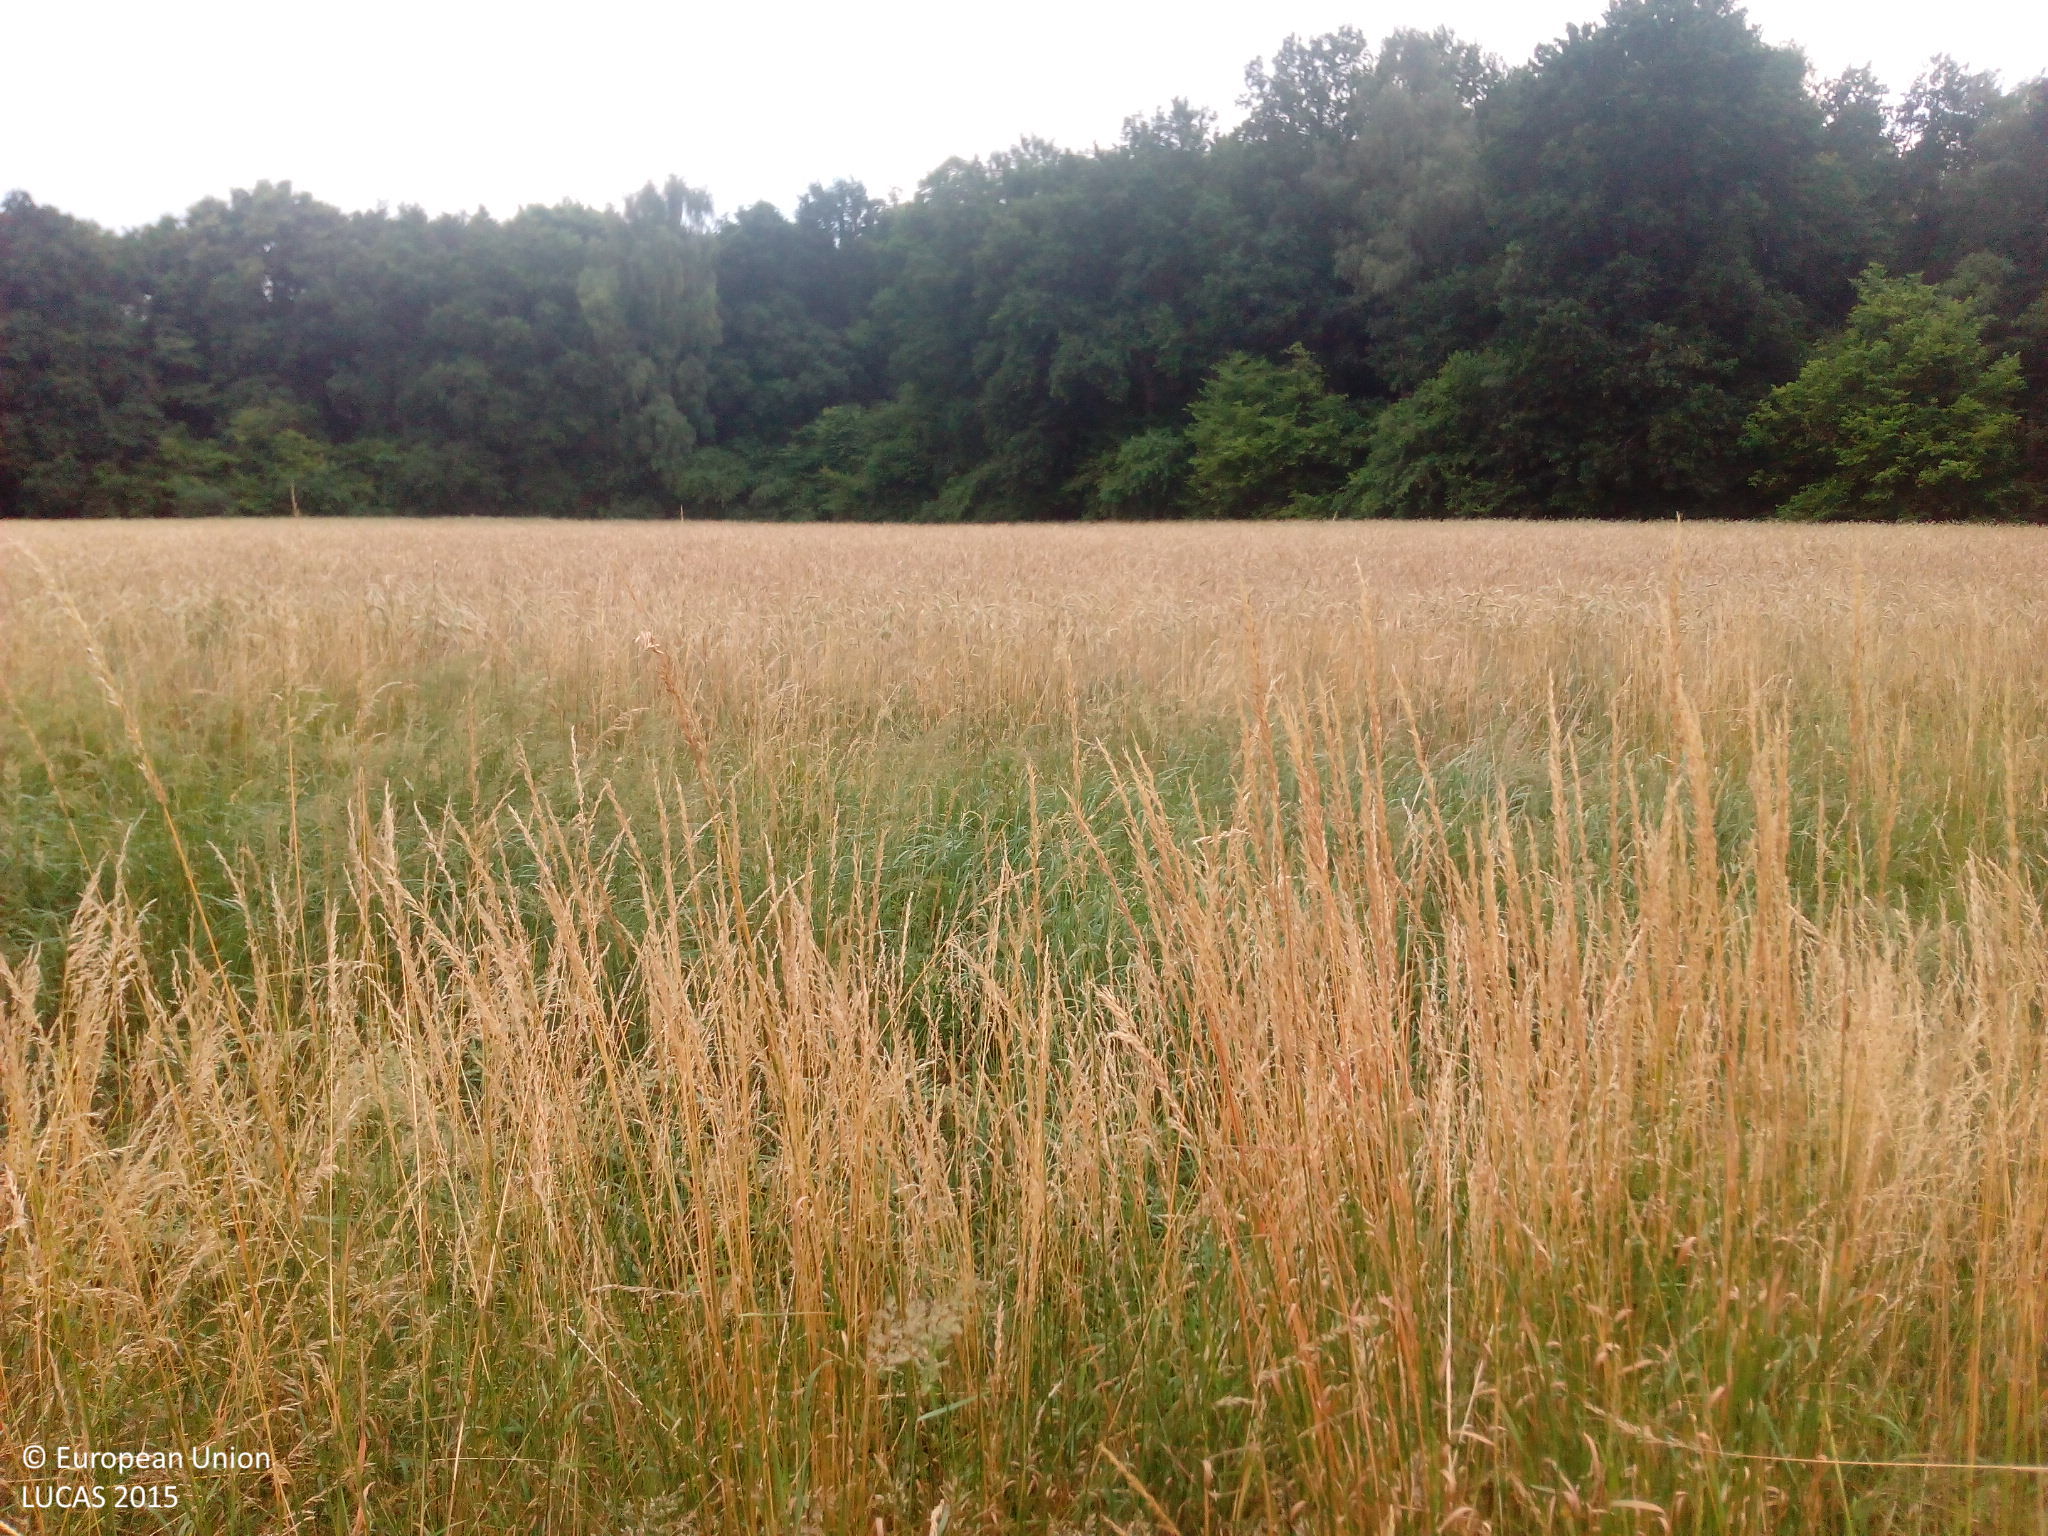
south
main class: Cropland
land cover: Rye
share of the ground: > 75 %
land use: Agriculture (excluding fallow land and kitchen gardens)
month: July
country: DE
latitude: 52.8922
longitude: 12.4222
